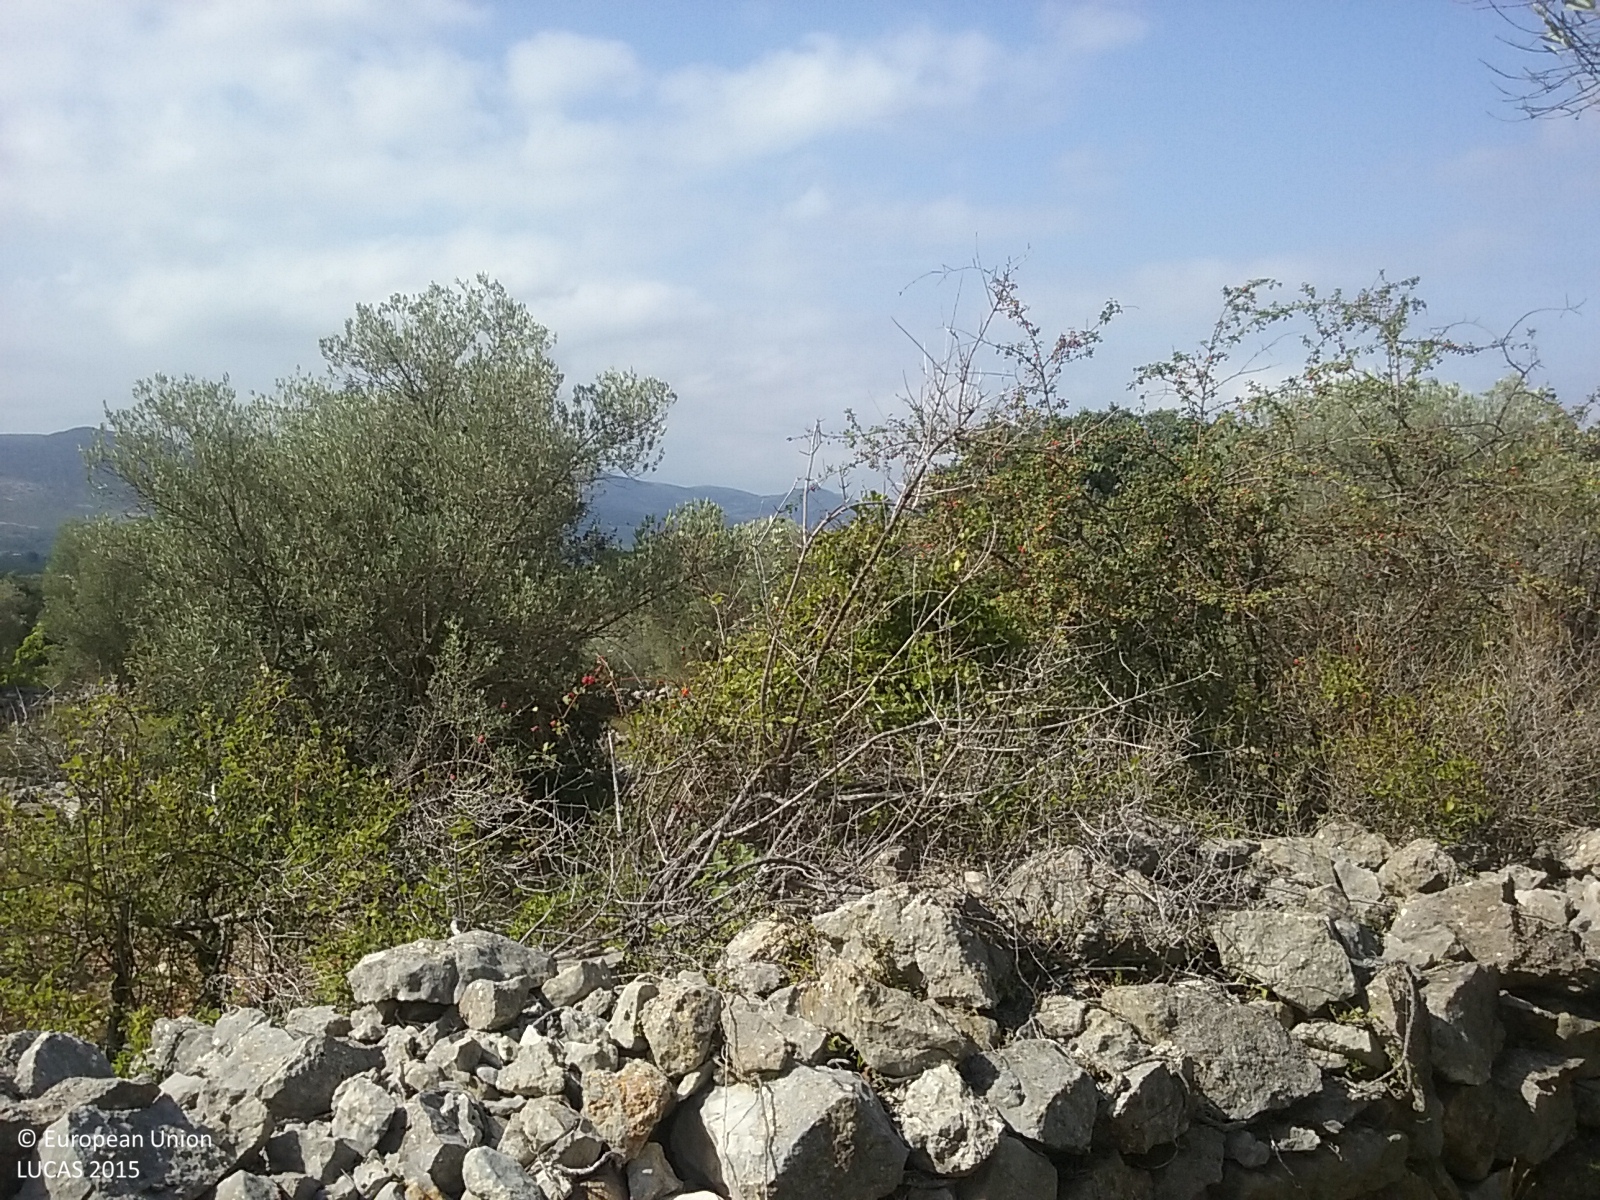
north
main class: Cropland
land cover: Olive groves
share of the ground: 25 - 50 %
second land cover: Spontaneously vegetated surfaces
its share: 25 - 50 %
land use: Agriculture (excluding fallow land and kitchen gardens)
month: August
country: ES
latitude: 40.3383
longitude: 0.0018
